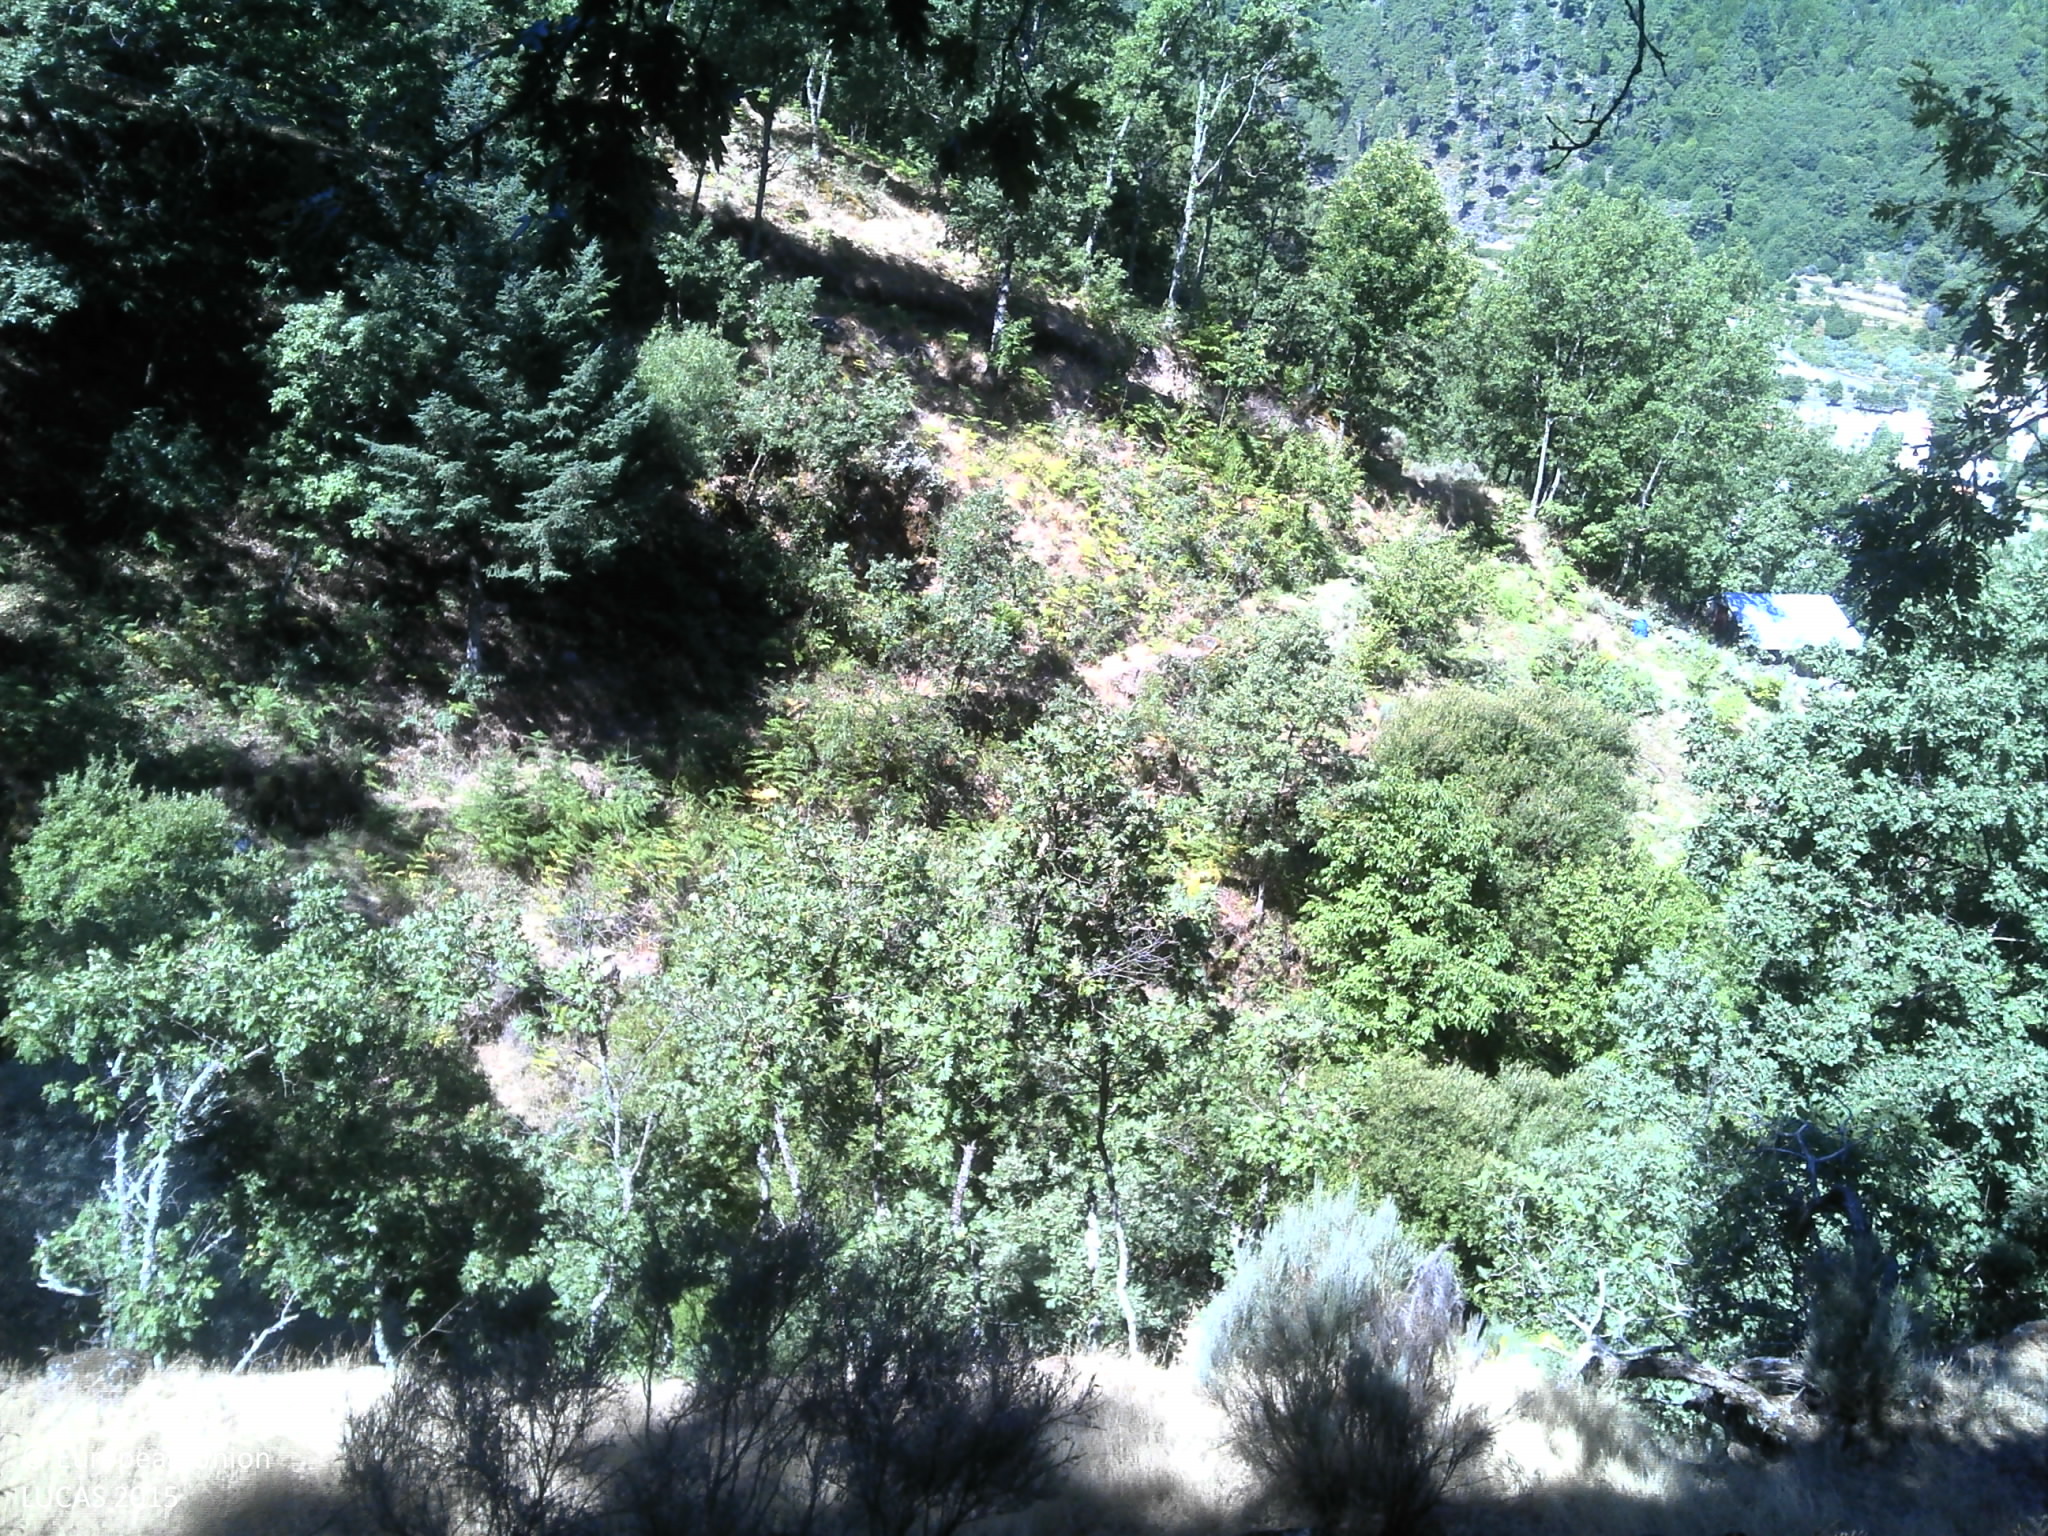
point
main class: Shrubland
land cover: Shrubland with sparse tree cover
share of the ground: 50 - 75 %
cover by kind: shrubs 70 %, herbaceous plants 10 %, unconsolidated bare surface 10 %, broadleaved forest trees 5 %
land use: Abandoned areas
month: July
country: PT
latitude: 40.3910
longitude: -7.5337
